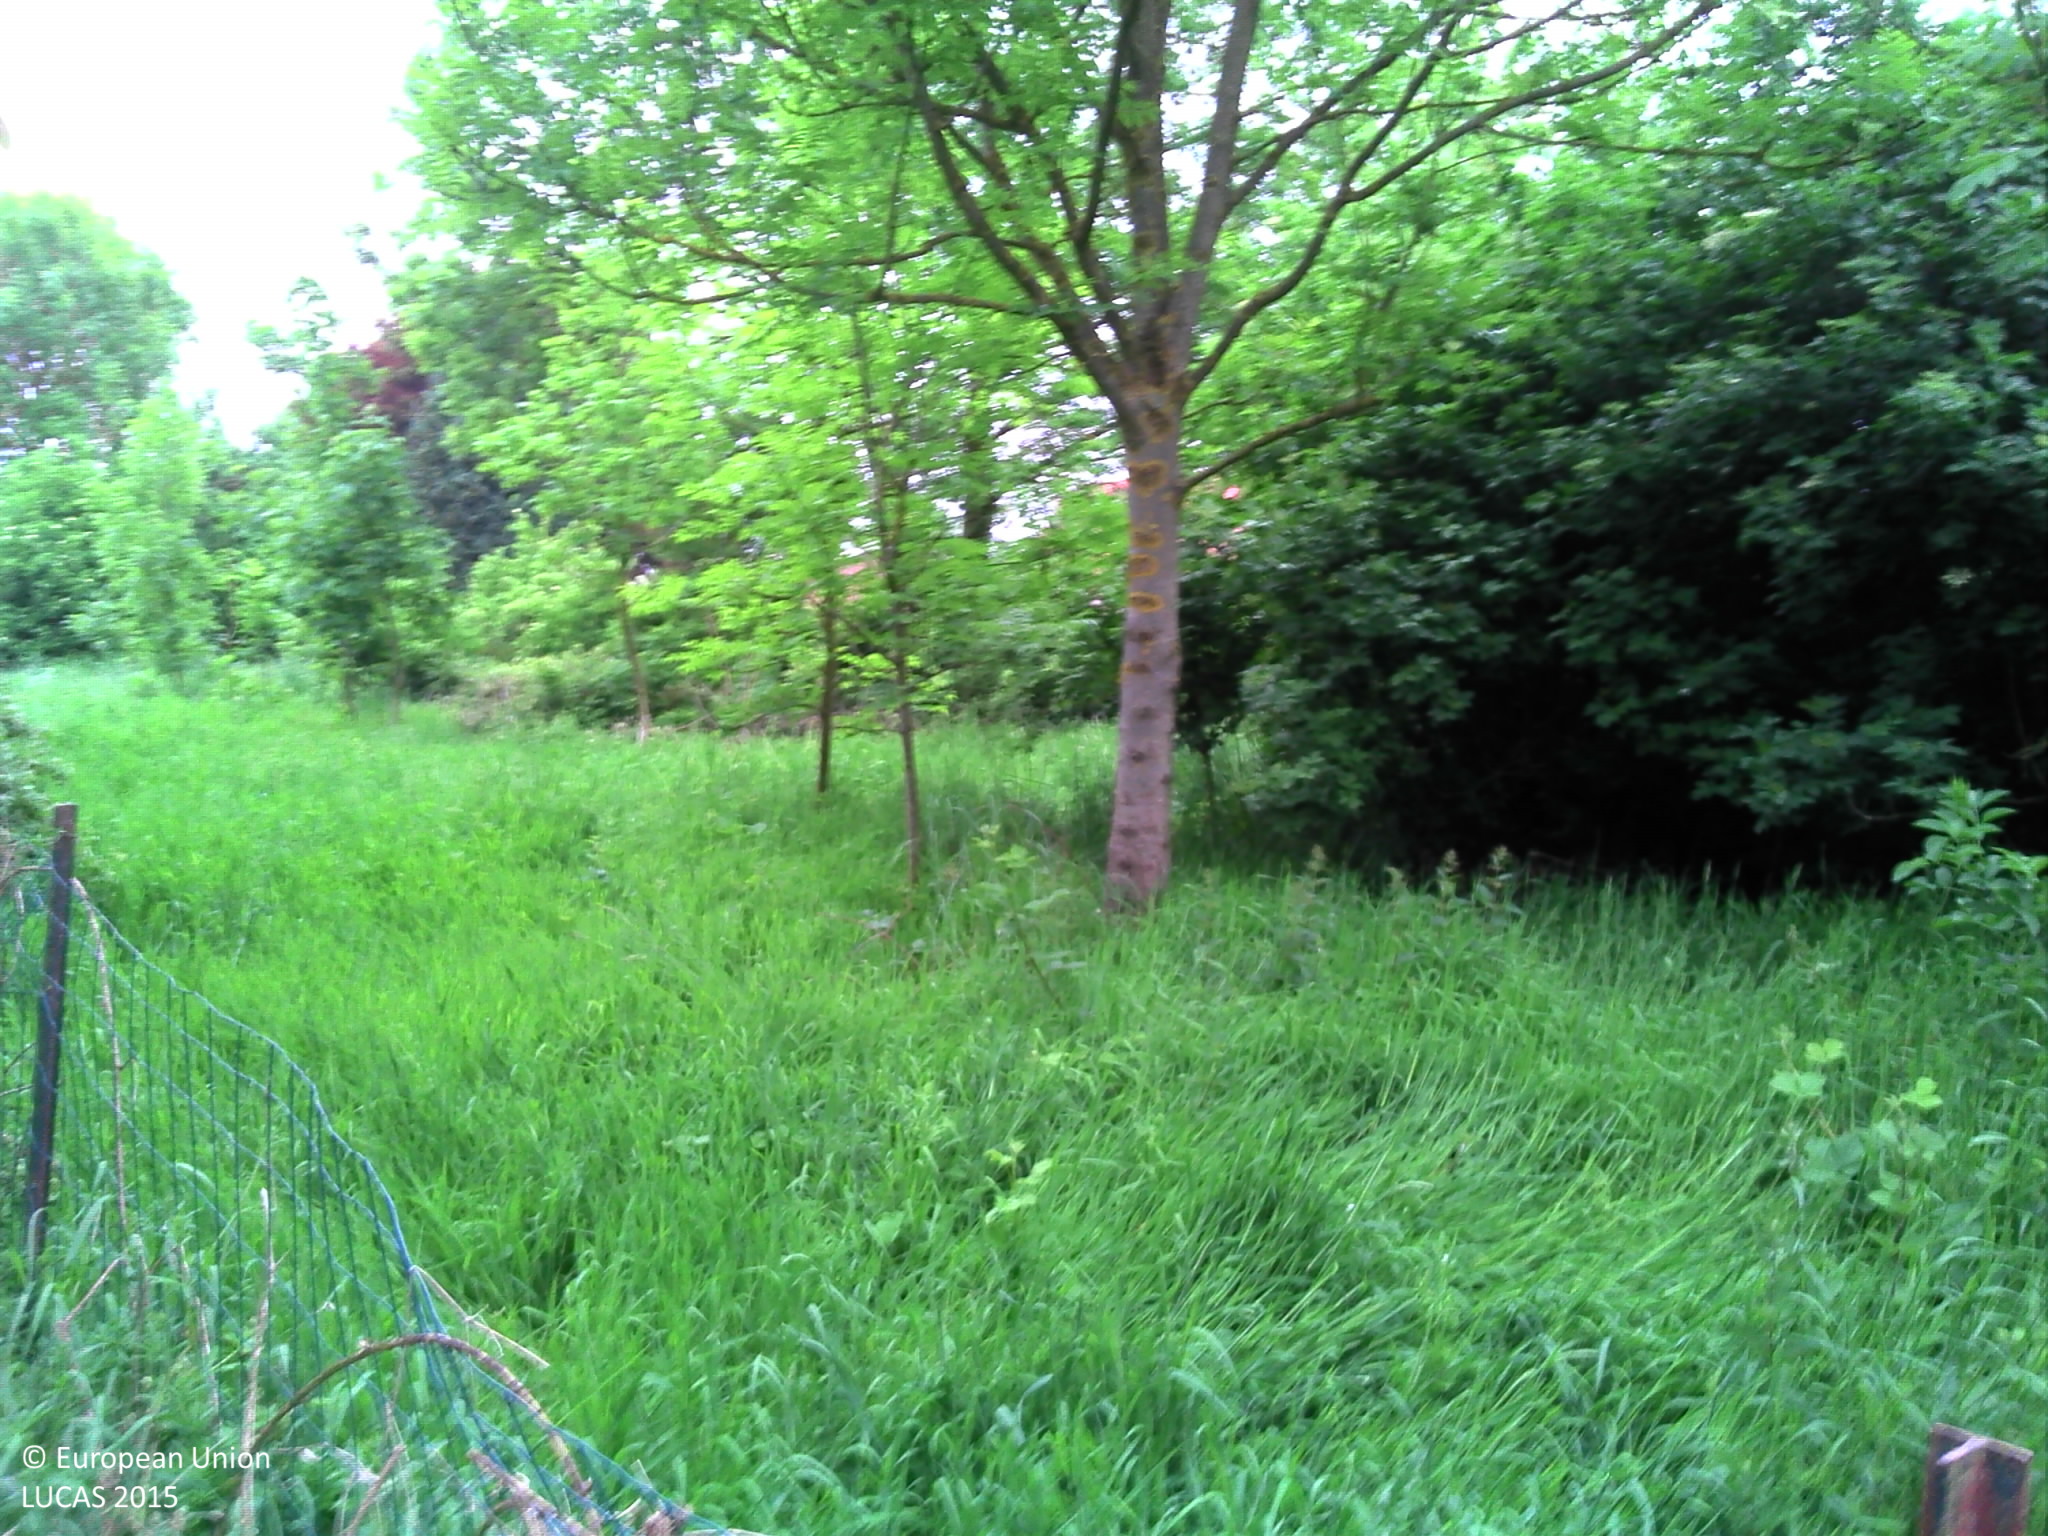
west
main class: Woodland
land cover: Broadleaved woodland
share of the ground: 50 - 75 %
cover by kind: broadleaved forest trees 60 %, herbaceous plants 40 %
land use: Residential
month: May
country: FR
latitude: 50.6090
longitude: 2.2847
